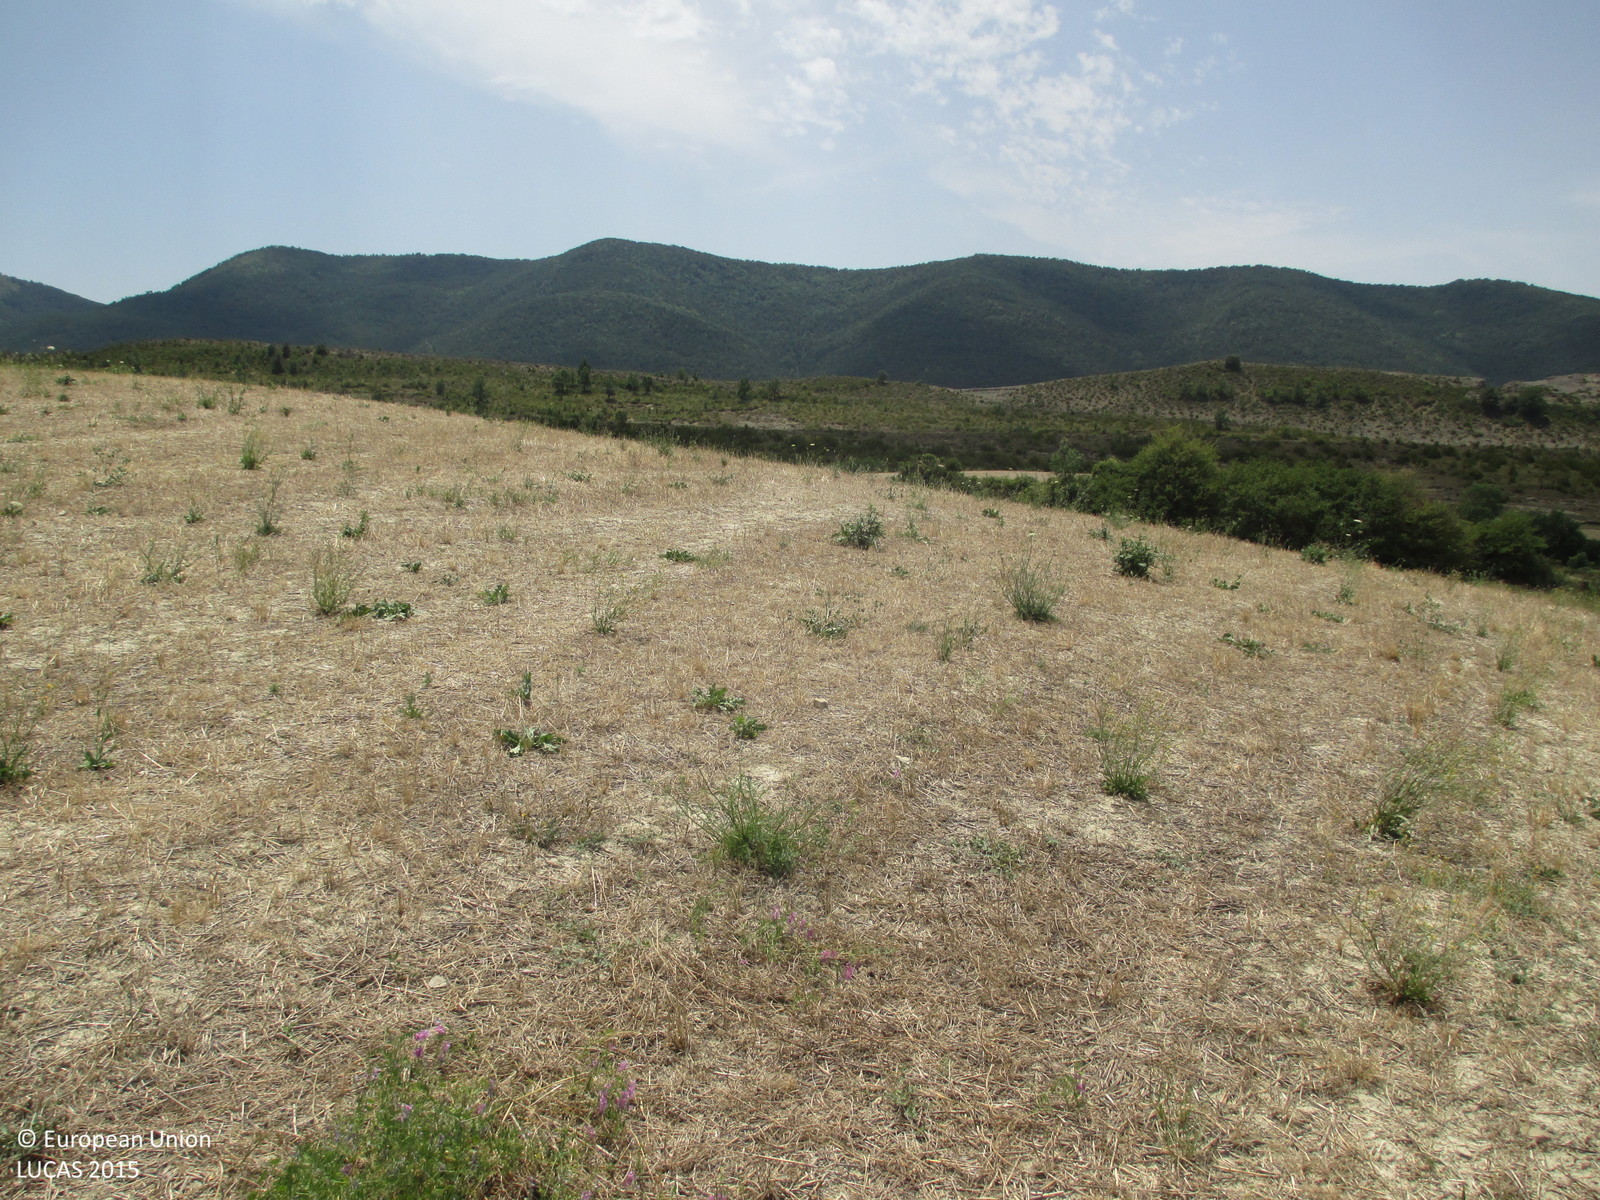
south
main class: Grassland
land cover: Spontaneously vegetated surfaces
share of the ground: > 75 %
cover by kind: herbaceous plants 100 %
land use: Fallow land
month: July
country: ES
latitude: 42.5062
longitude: -0.3328
